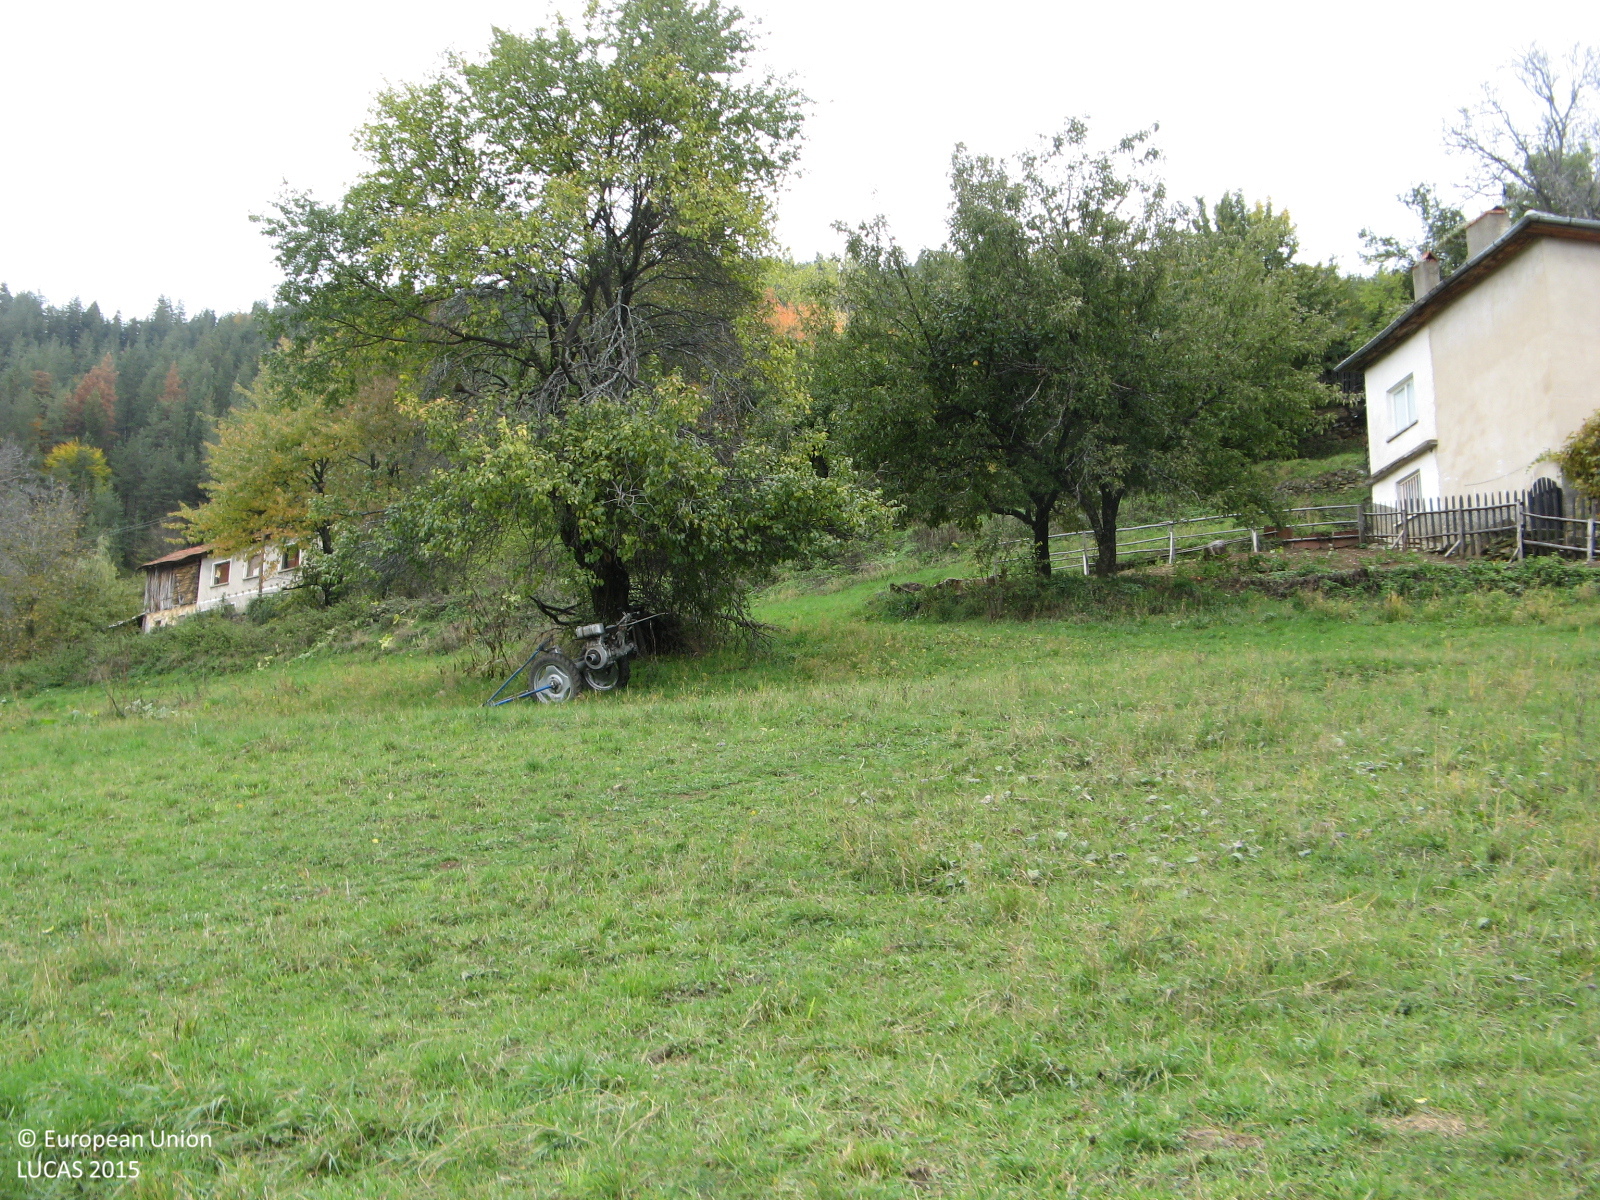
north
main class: Grassland
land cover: Grassland without tree/shrub cover
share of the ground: > 75 %
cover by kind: herbaceous plants 100 %
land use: Agriculture (excluding fallow land and kitchen gardens)
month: October
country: BG
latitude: 41.5979
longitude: 24.7906
